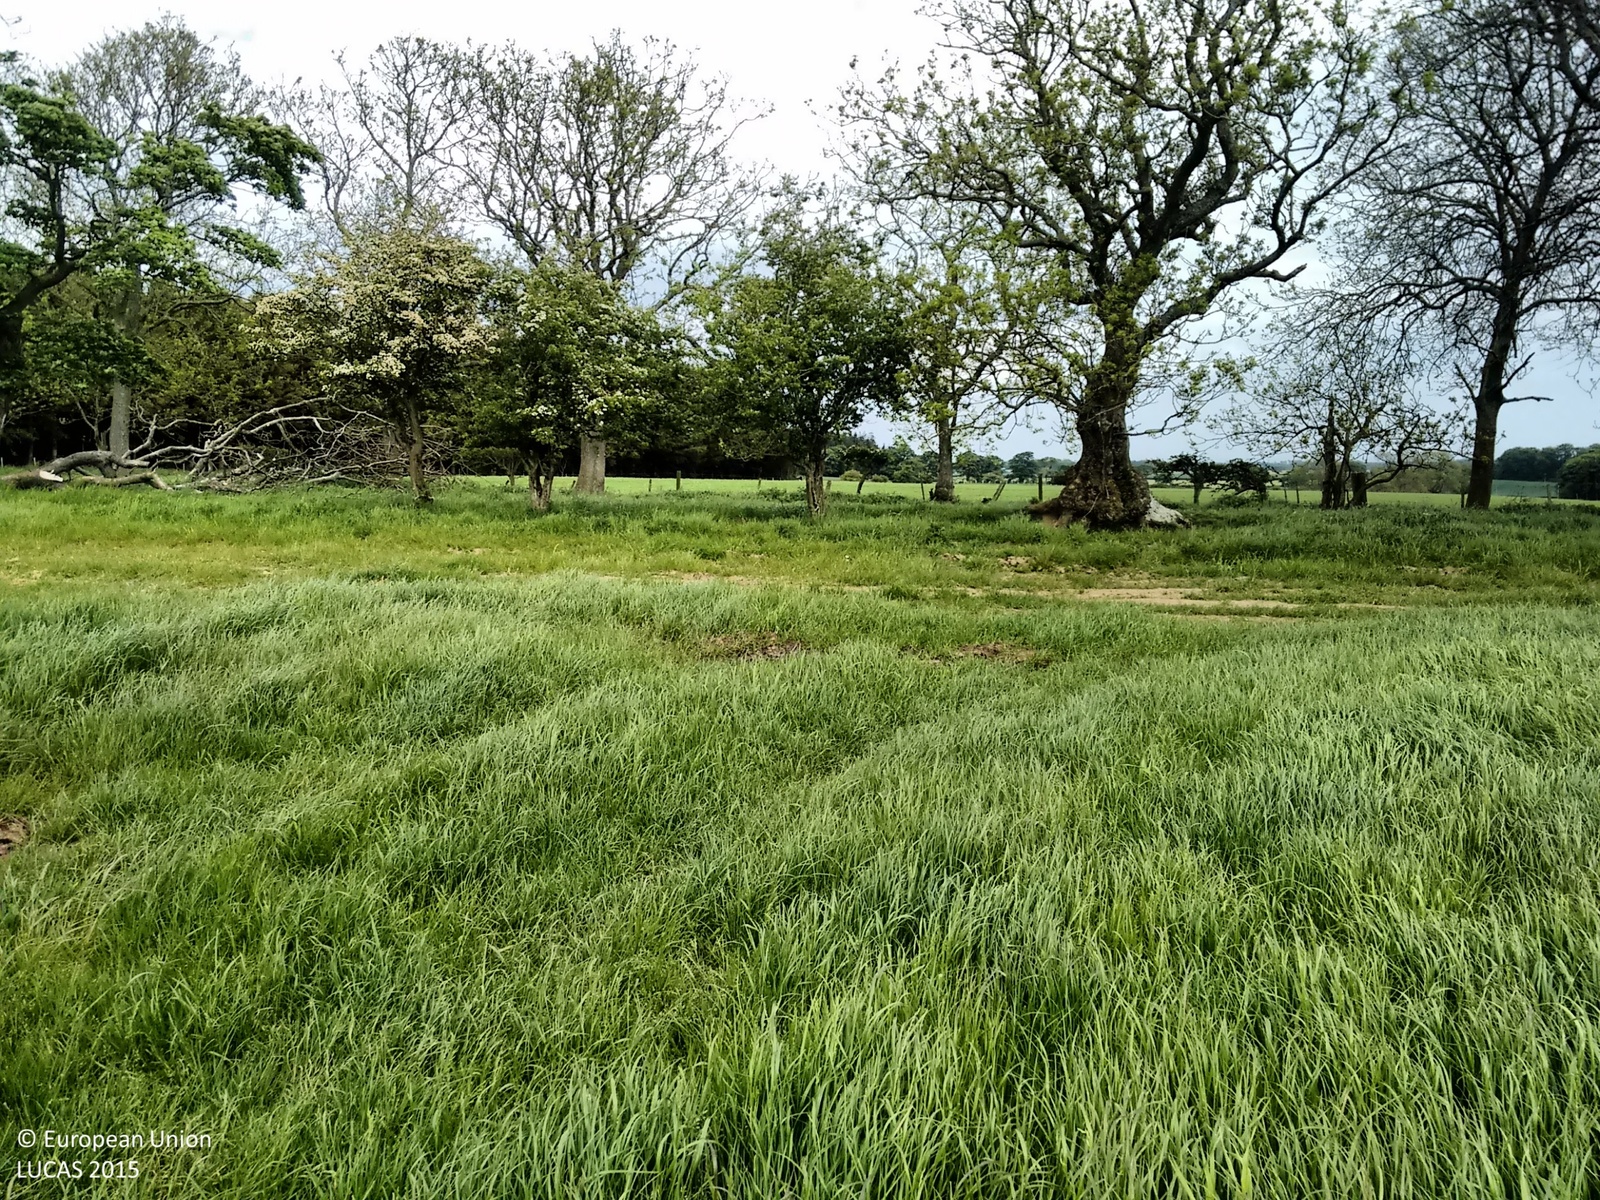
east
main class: Cropland
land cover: Temporary grasslands
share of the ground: > 75 %
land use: Agriculture (excluding fallow land and kitchen gardens)
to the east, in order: Temporary grasslands; Lines of trees; Tracks; Lines of trees; Fences; Permanent crops (only in case pi)
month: June
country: GB
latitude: 55.4827
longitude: -1.7431
